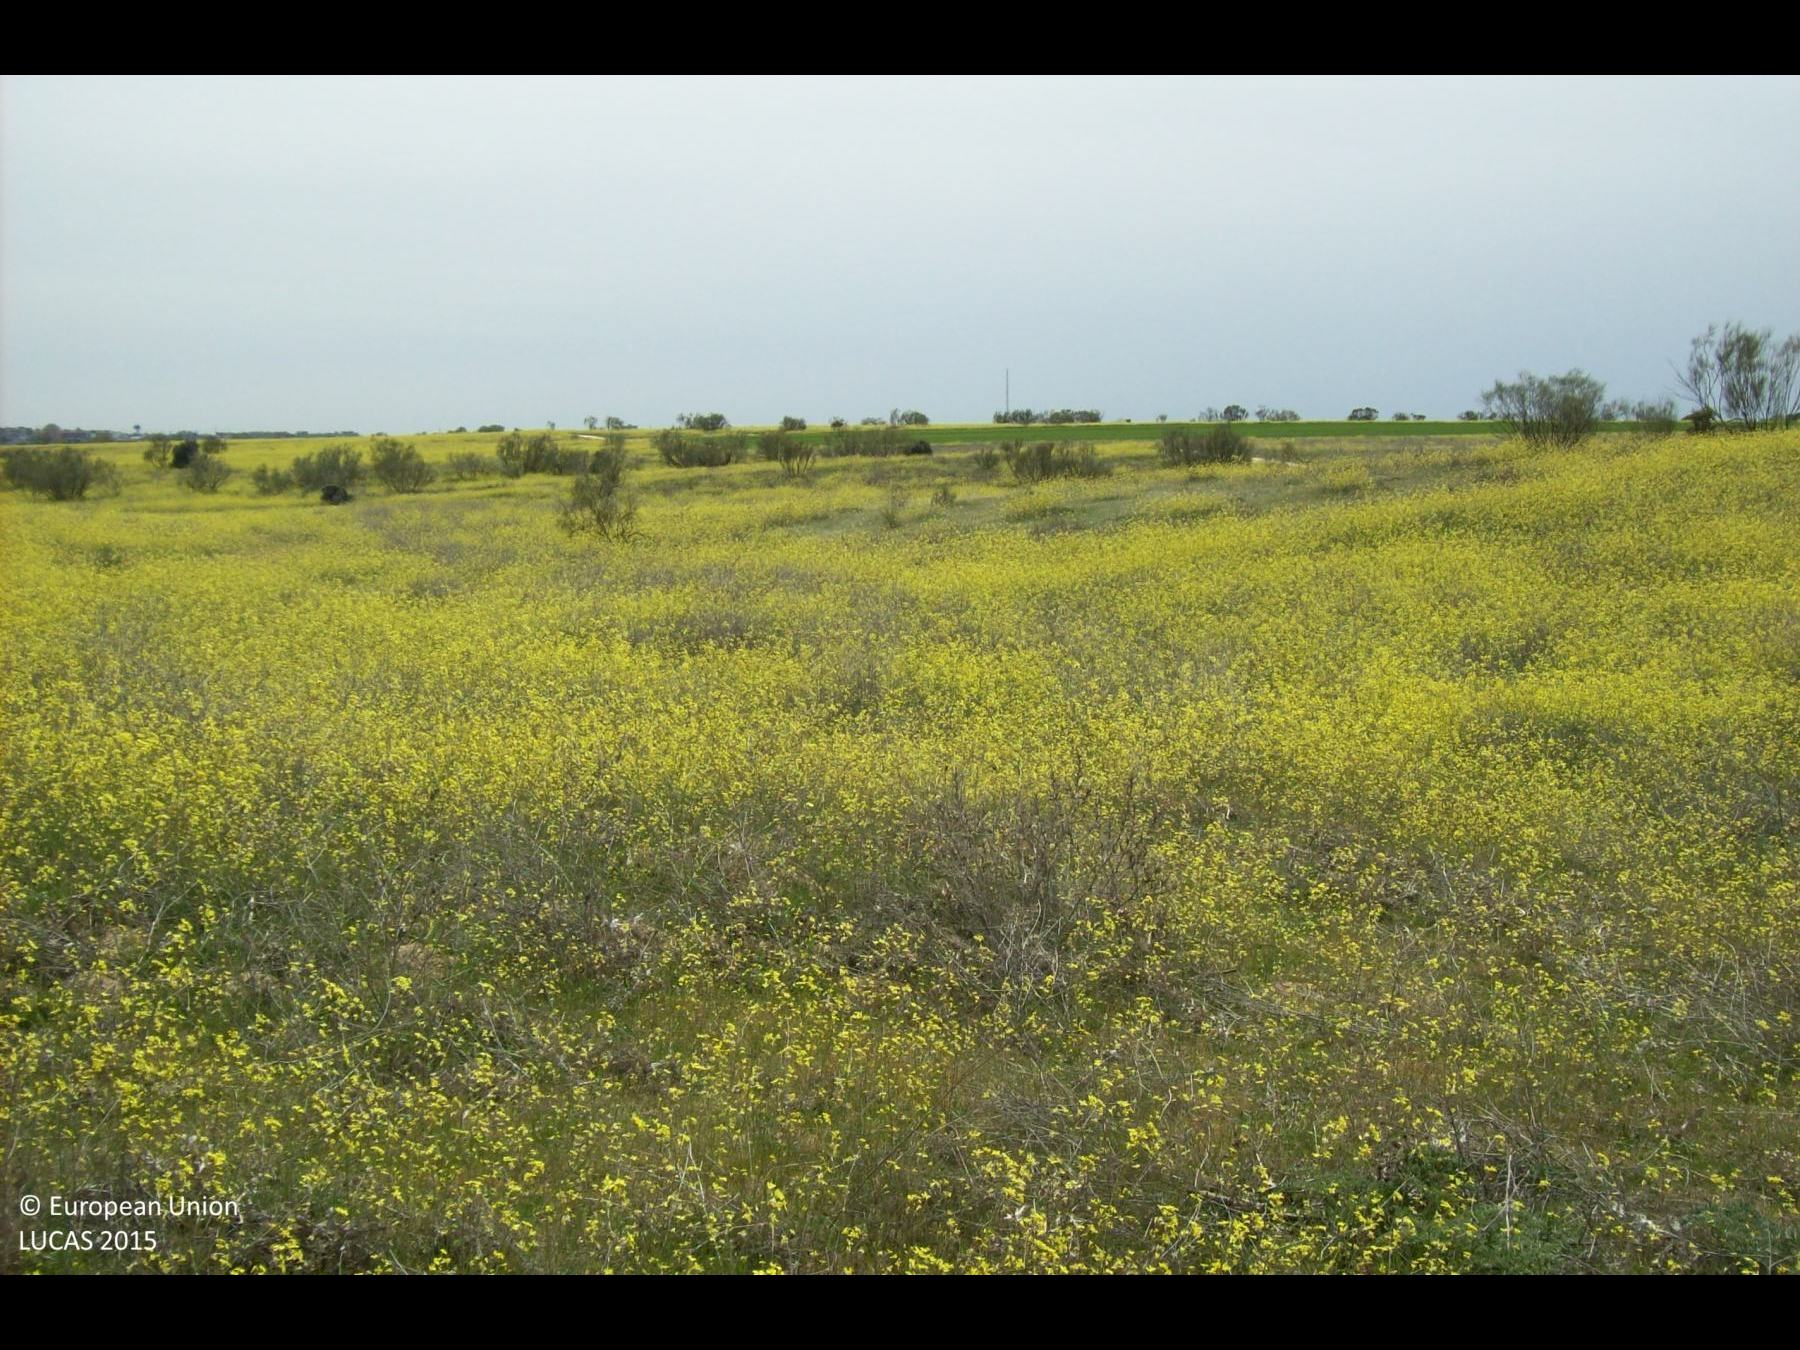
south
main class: Grassland
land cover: Spontaneously vegetated surfaces
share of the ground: > 75 %
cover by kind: herbaceous plants 95 %, shrubs 5 %
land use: Semi-natural and natural areas not in use
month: April
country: ES
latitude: 40.3817
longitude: -3.8322
